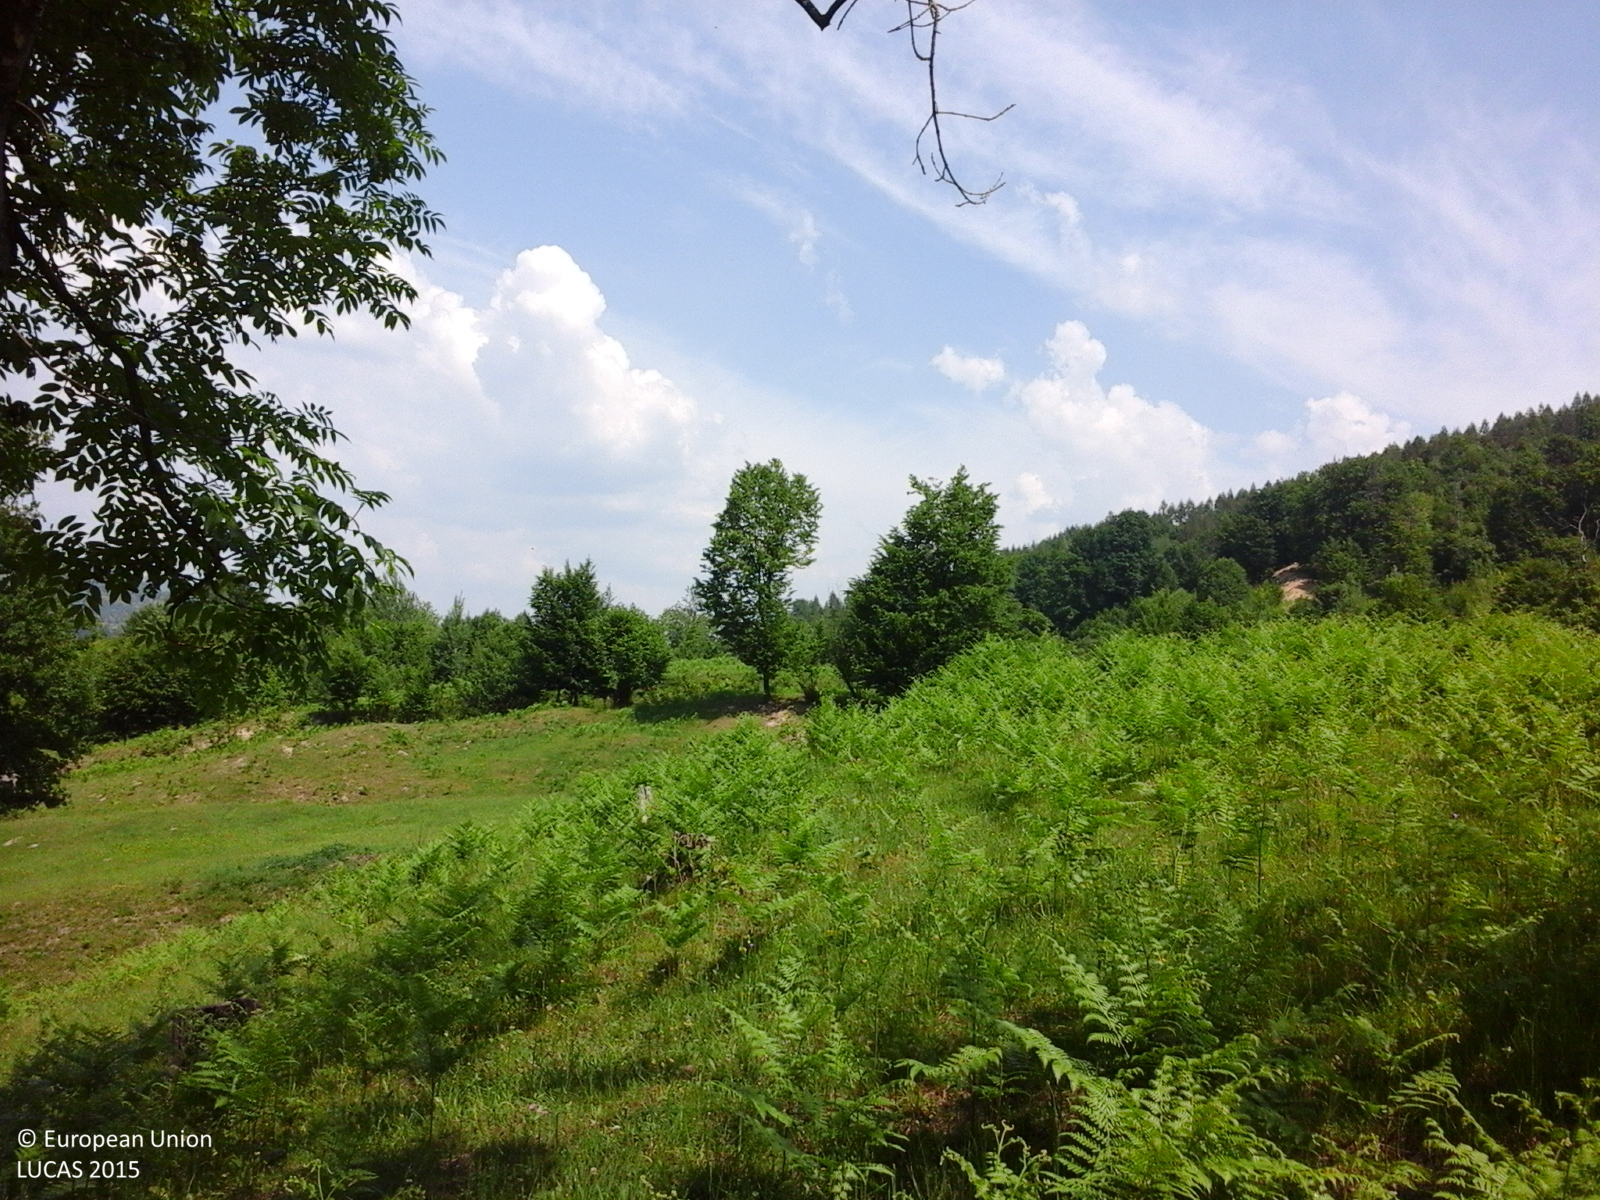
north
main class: Grassland
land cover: Grassland with sparse tree/shrub cover
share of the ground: > 75 %
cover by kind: herbaceous plants 95 %, broadleaved forest trees 5 %
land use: Agriculture (excluding fallow land and kitchen gardens)
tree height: > 5 m
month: June
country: RO
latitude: 46.3360
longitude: 26.4351
